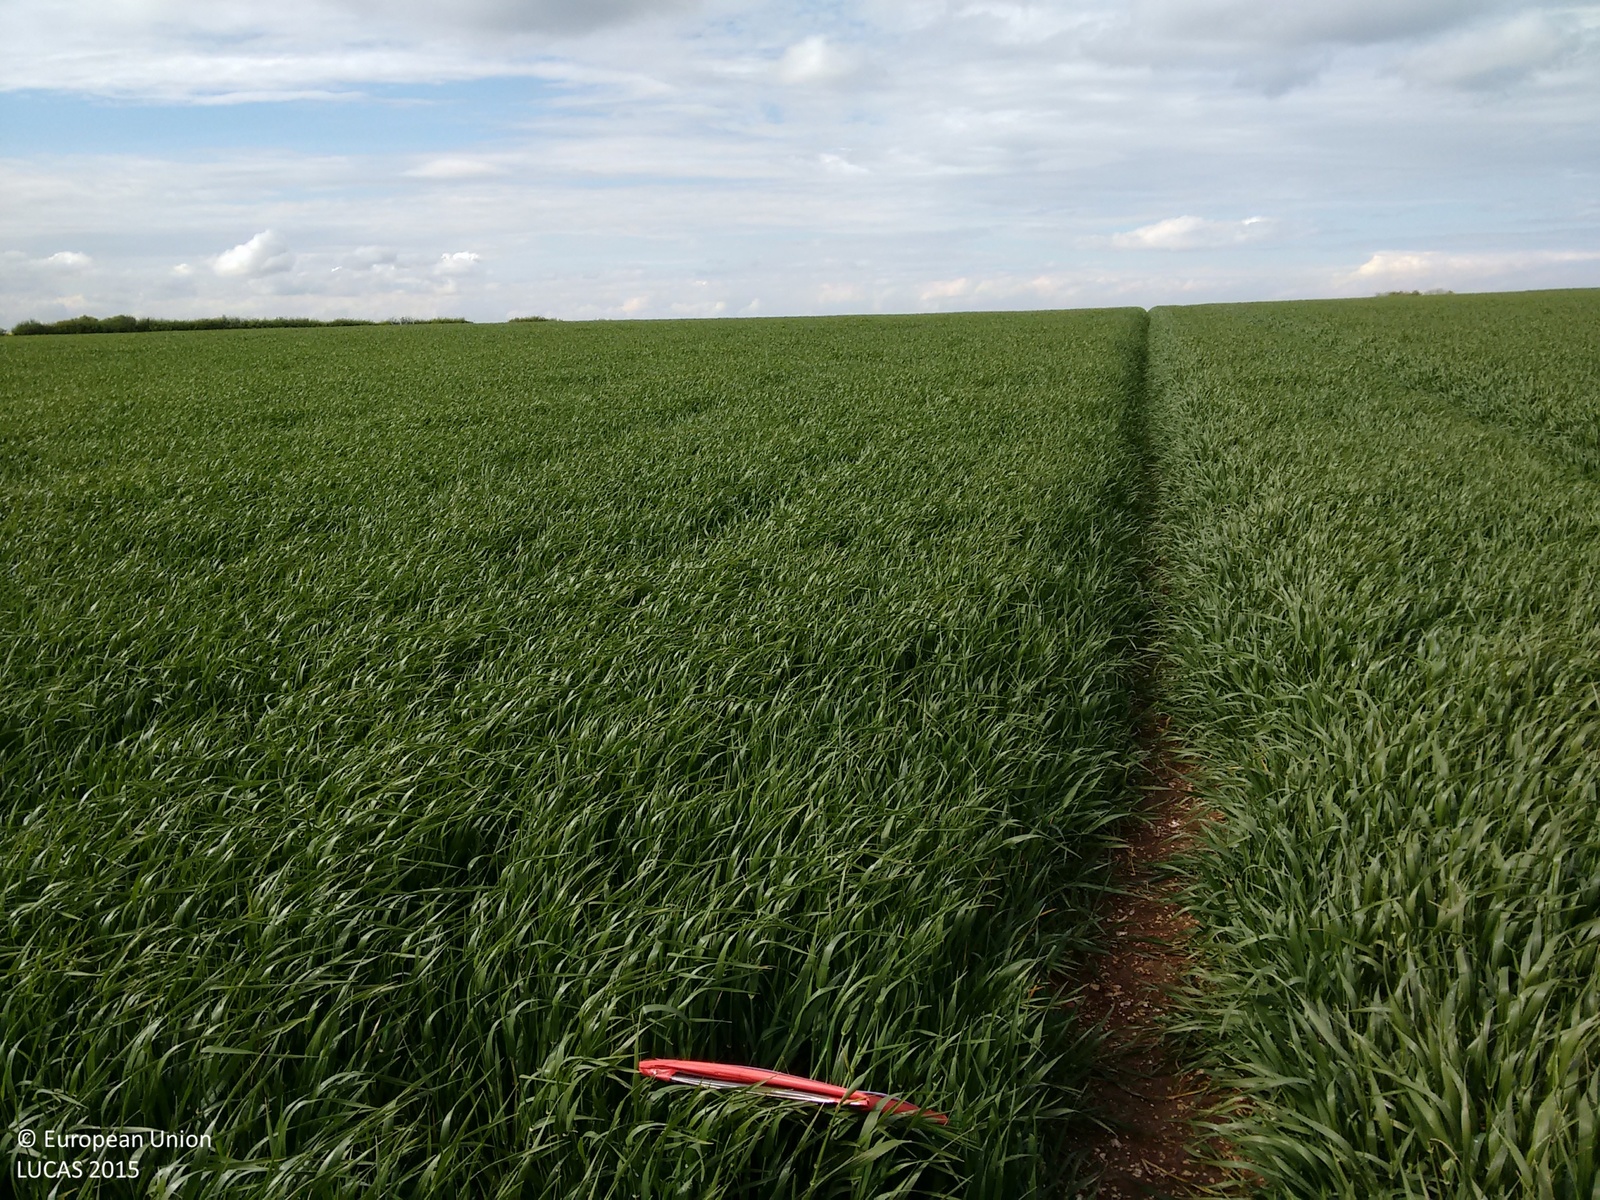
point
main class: Cropland
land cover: Barley
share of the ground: > 75 %
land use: Agriculture (excluding fallow land and kitchen gardens)
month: May
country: GB
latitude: 53.3121
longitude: -0.0131
